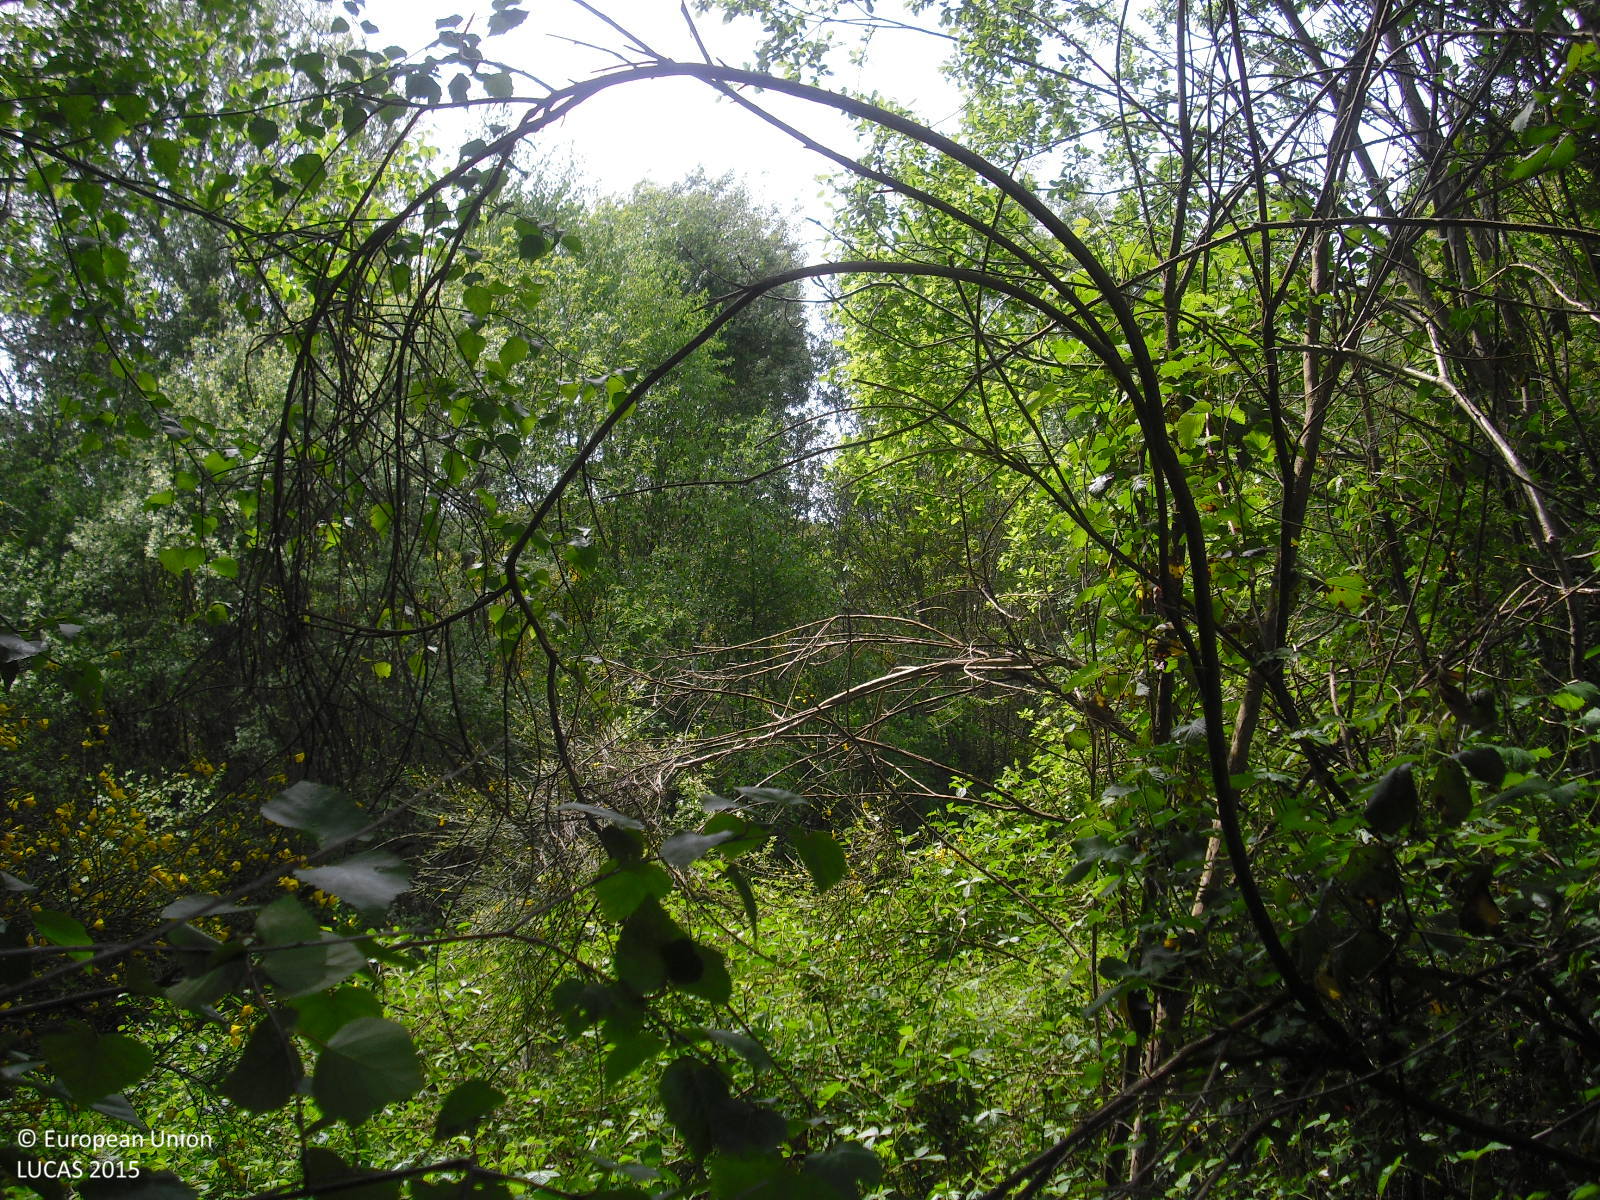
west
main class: Woodland
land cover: Broadleaved woodland
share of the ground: 50 - 75 %
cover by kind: broadleaved forest trees 60 %, shrubs 40 %
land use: Abandoned areas
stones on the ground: < 10 %
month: May
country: ES
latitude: 42.1420
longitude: -7.8485
